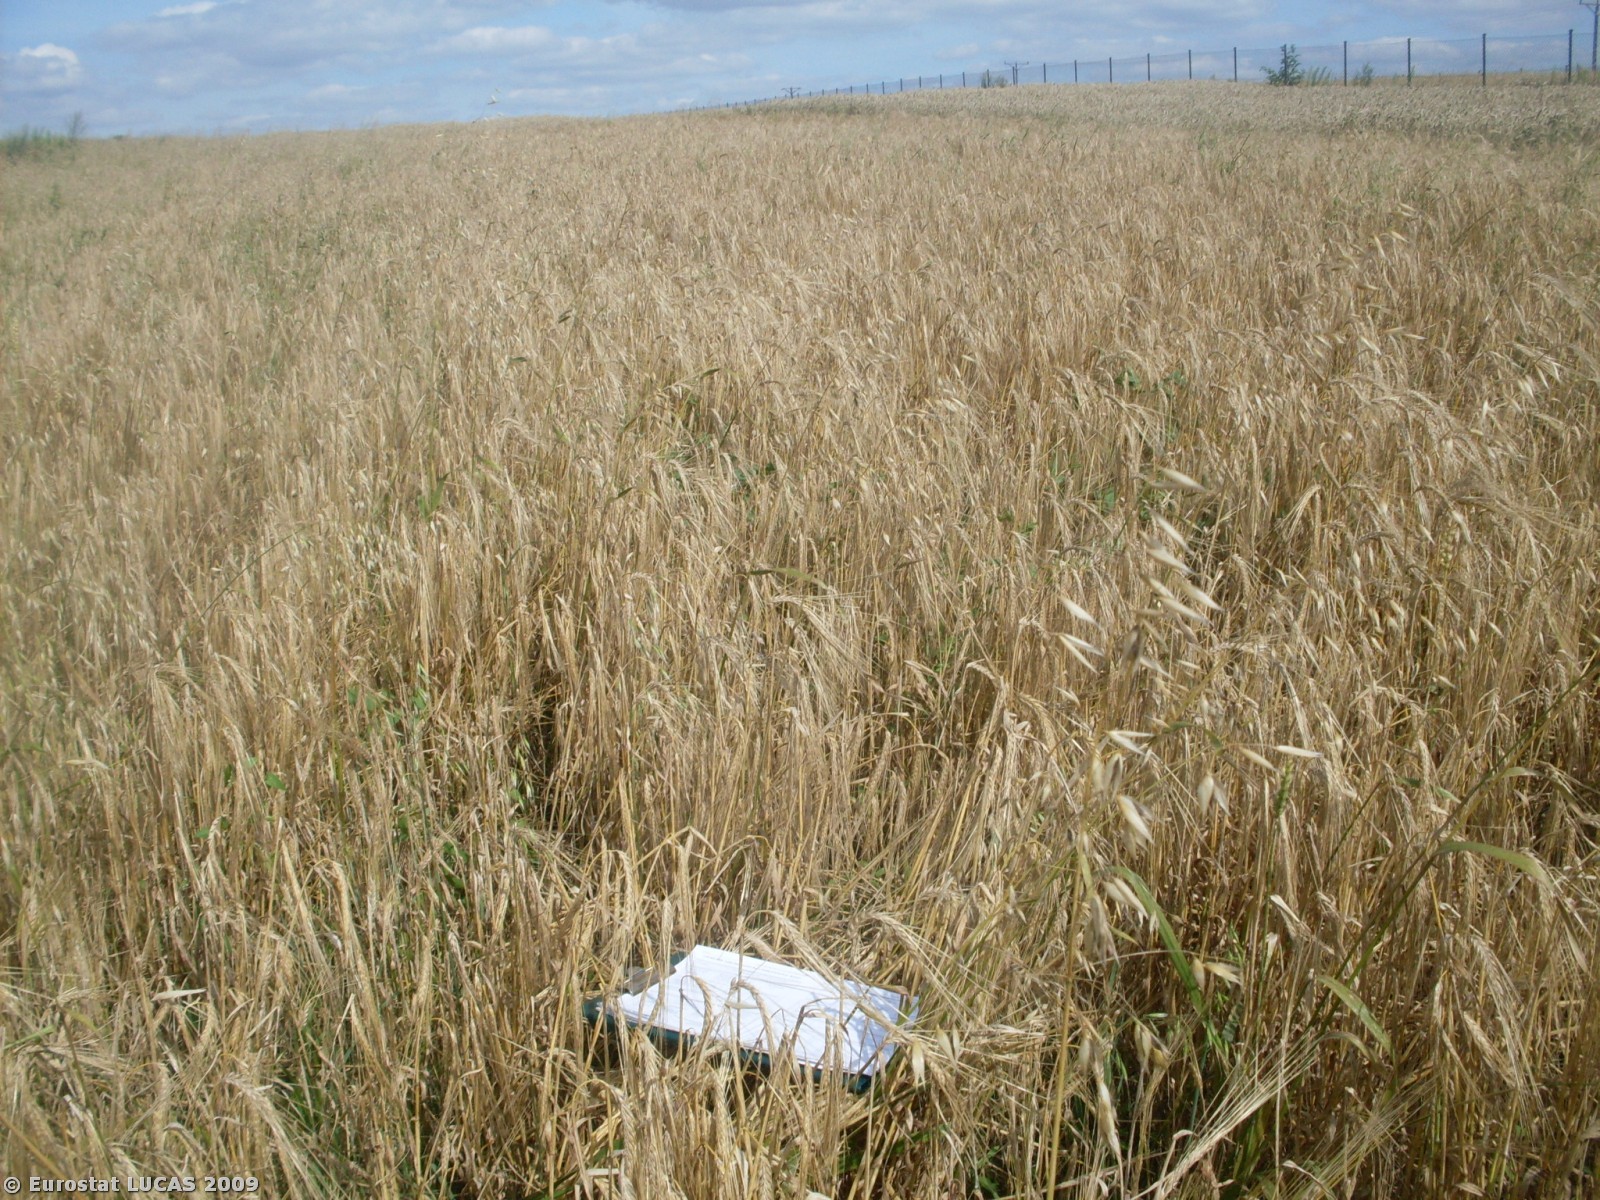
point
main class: Cropland
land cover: Mixed cereals for fodder
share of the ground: > 75 %
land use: Agriculture (excluding fallow land and kitchen gardens)
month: July
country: PL
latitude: 50.3015
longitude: 20.0429
